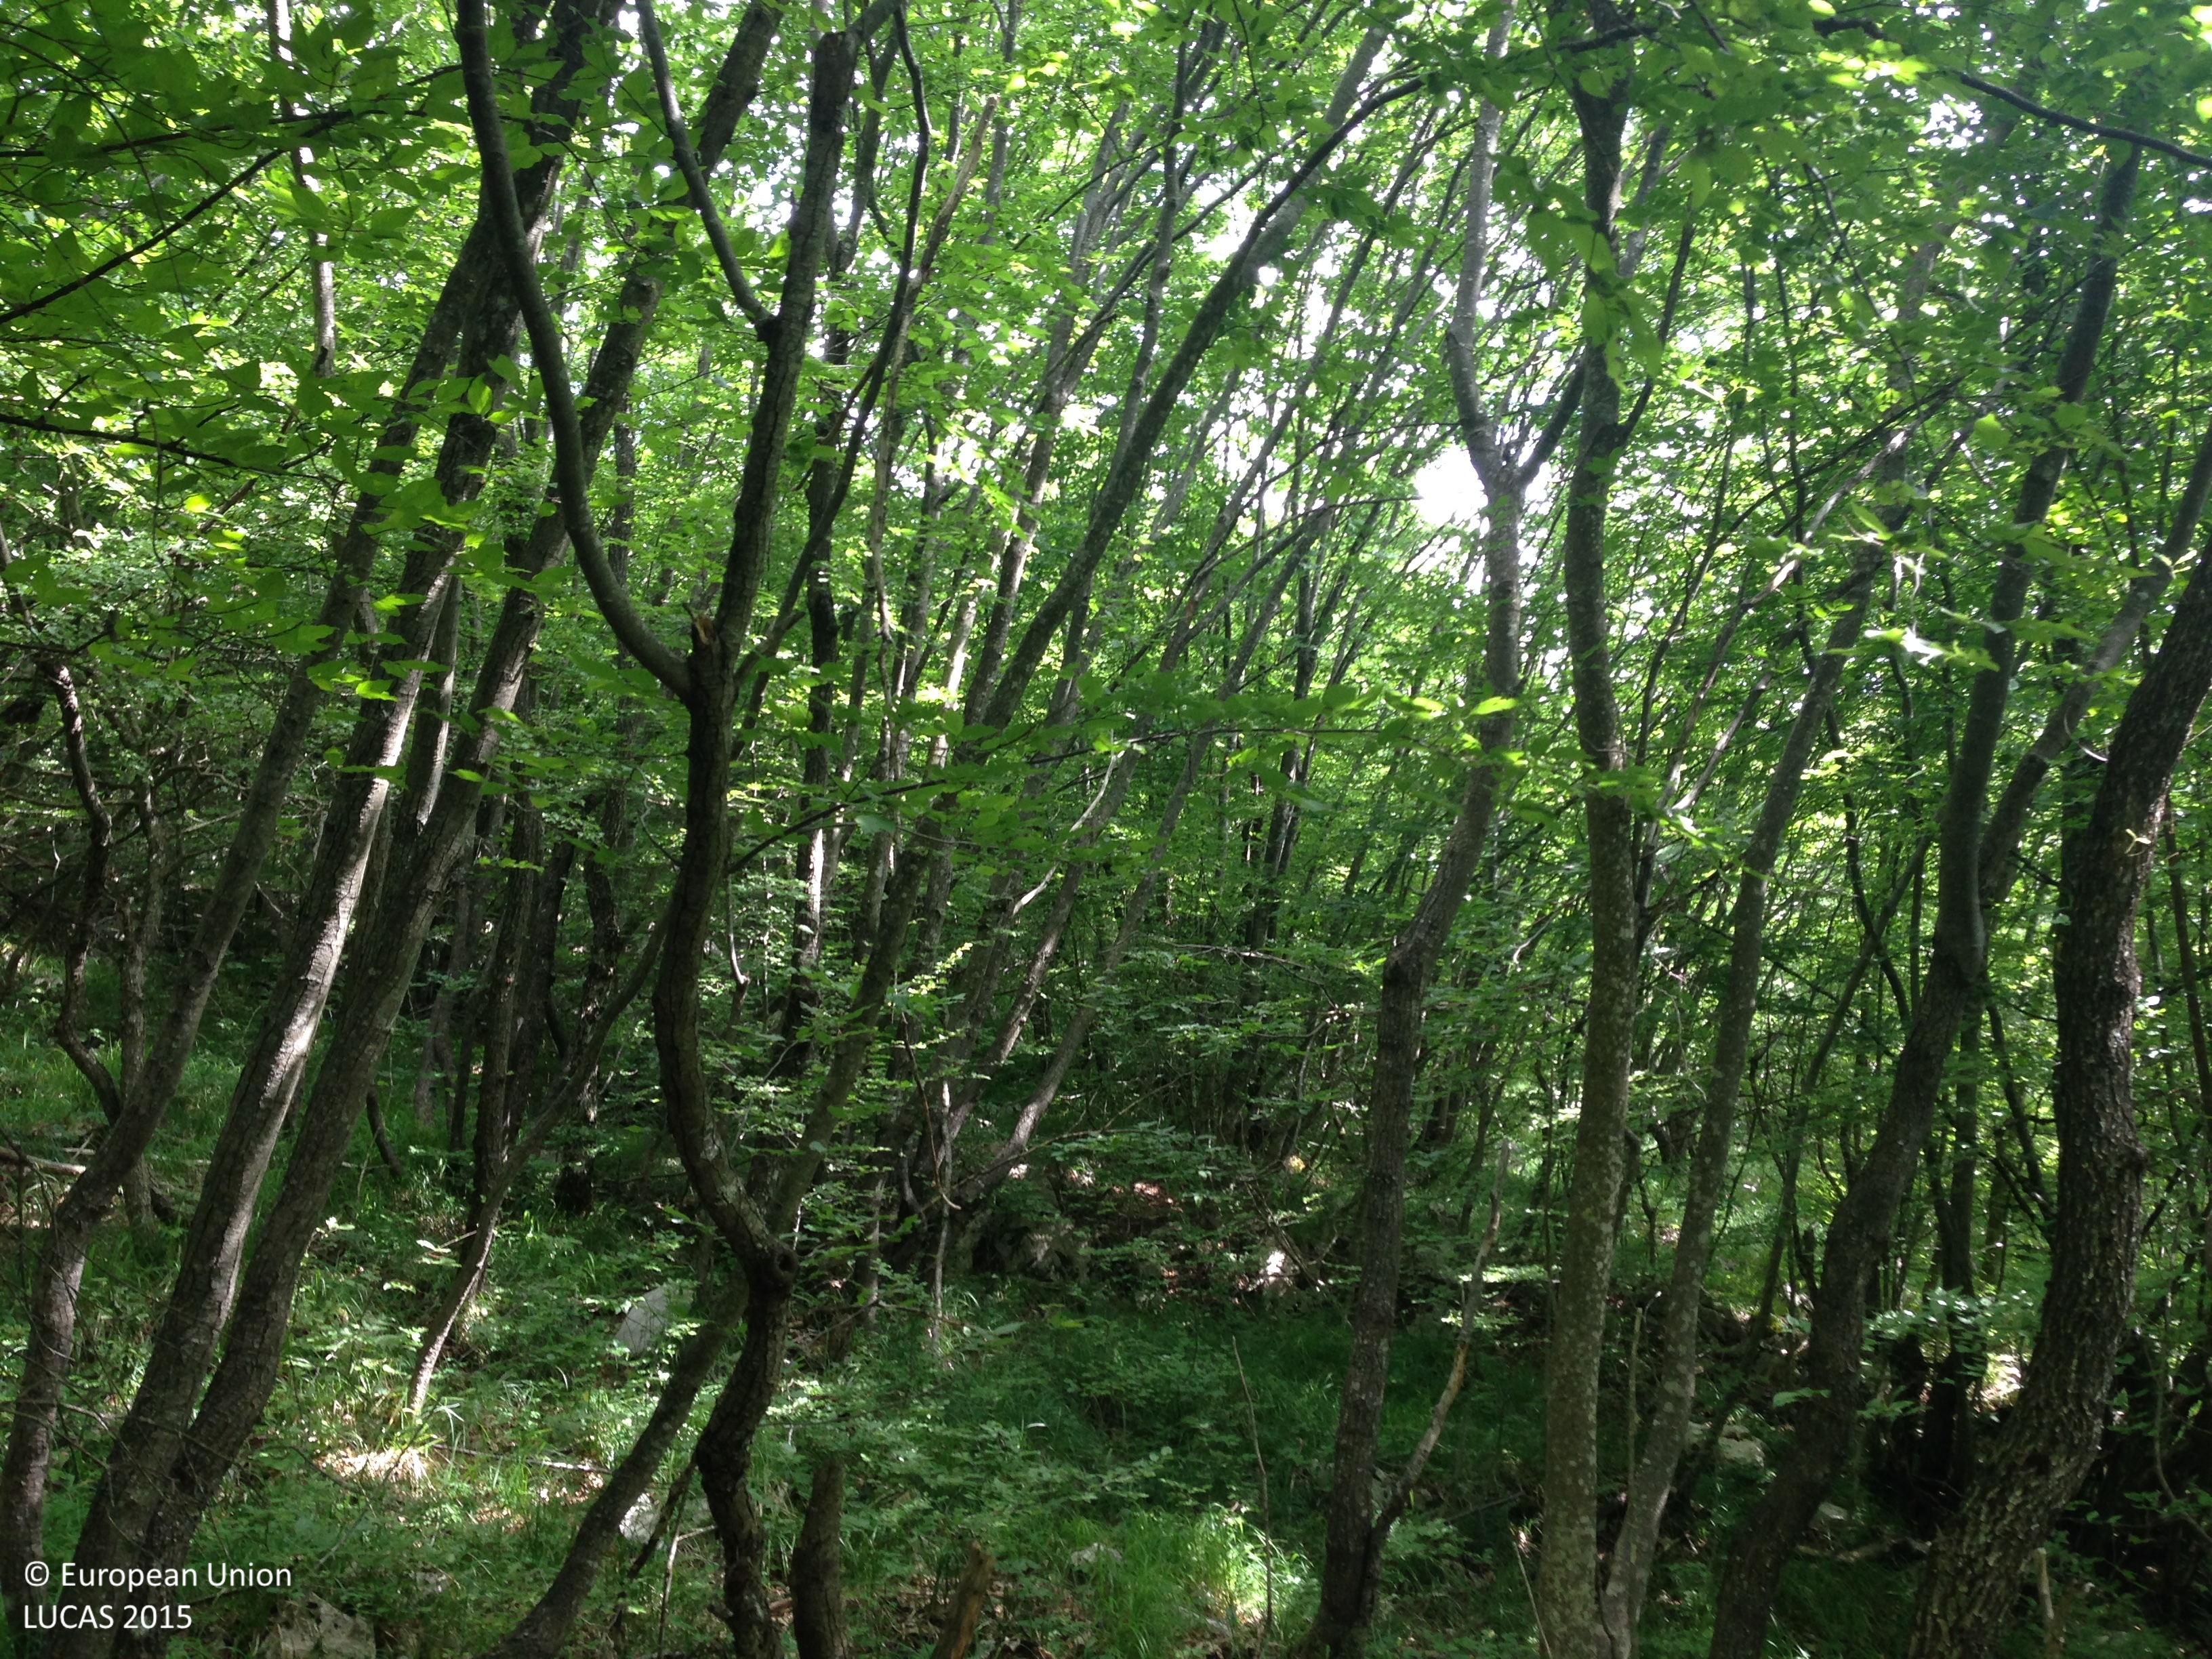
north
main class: Woodland
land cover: Broadleaved woodland
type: thermophilous deciduous forest
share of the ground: > 75 %
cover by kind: broadleaved forest trees 75 %, herbaceous plants 10 %, shrubs 5 %, lichens and mosses 5 %, unconsolidated bare surface 5 %
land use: Forestry
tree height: > 5 m
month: June
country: HR
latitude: 44.6980
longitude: 15.7362
